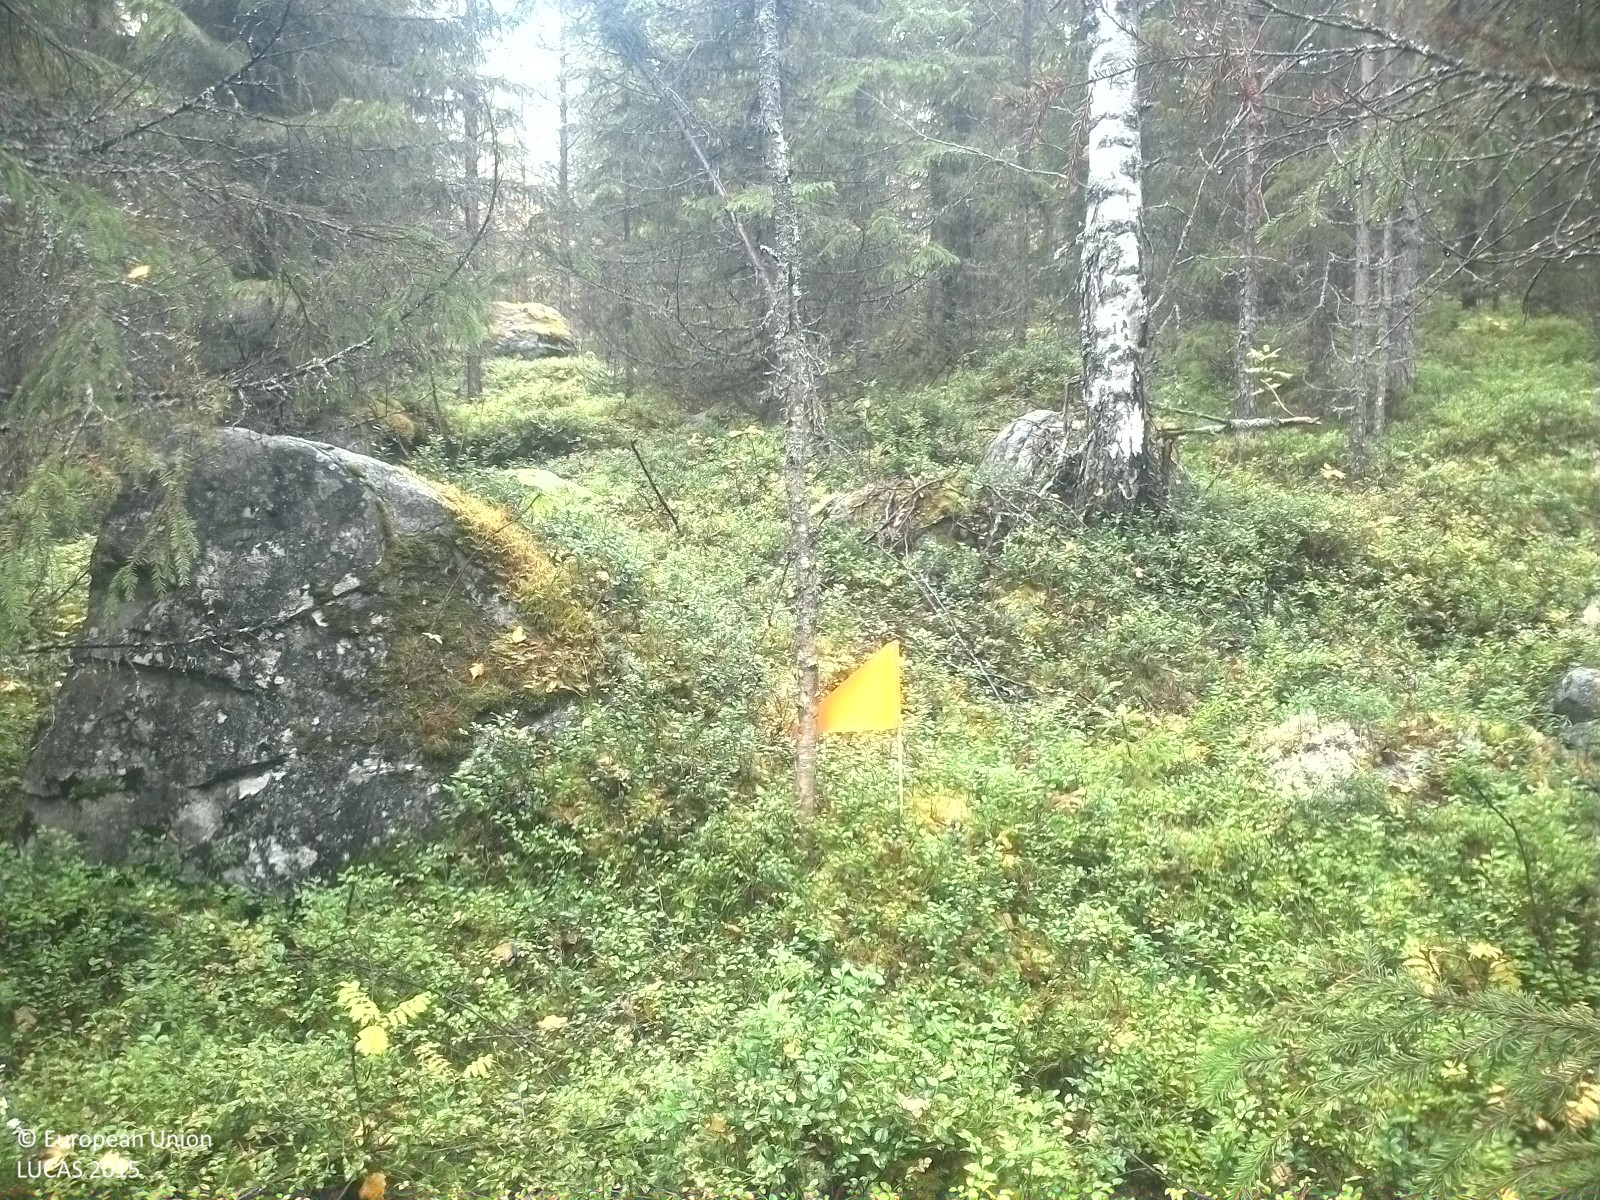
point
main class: Woodland
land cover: Spruce dominated mixed woodland
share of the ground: 50 - 75 %
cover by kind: broadleaved forest trees 40 %, shrubs 40 %, coniferous forest trees 15 %, lichens and mosses 5 %
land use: Forestry
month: September
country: SE
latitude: 62.2722
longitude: 15.6255
